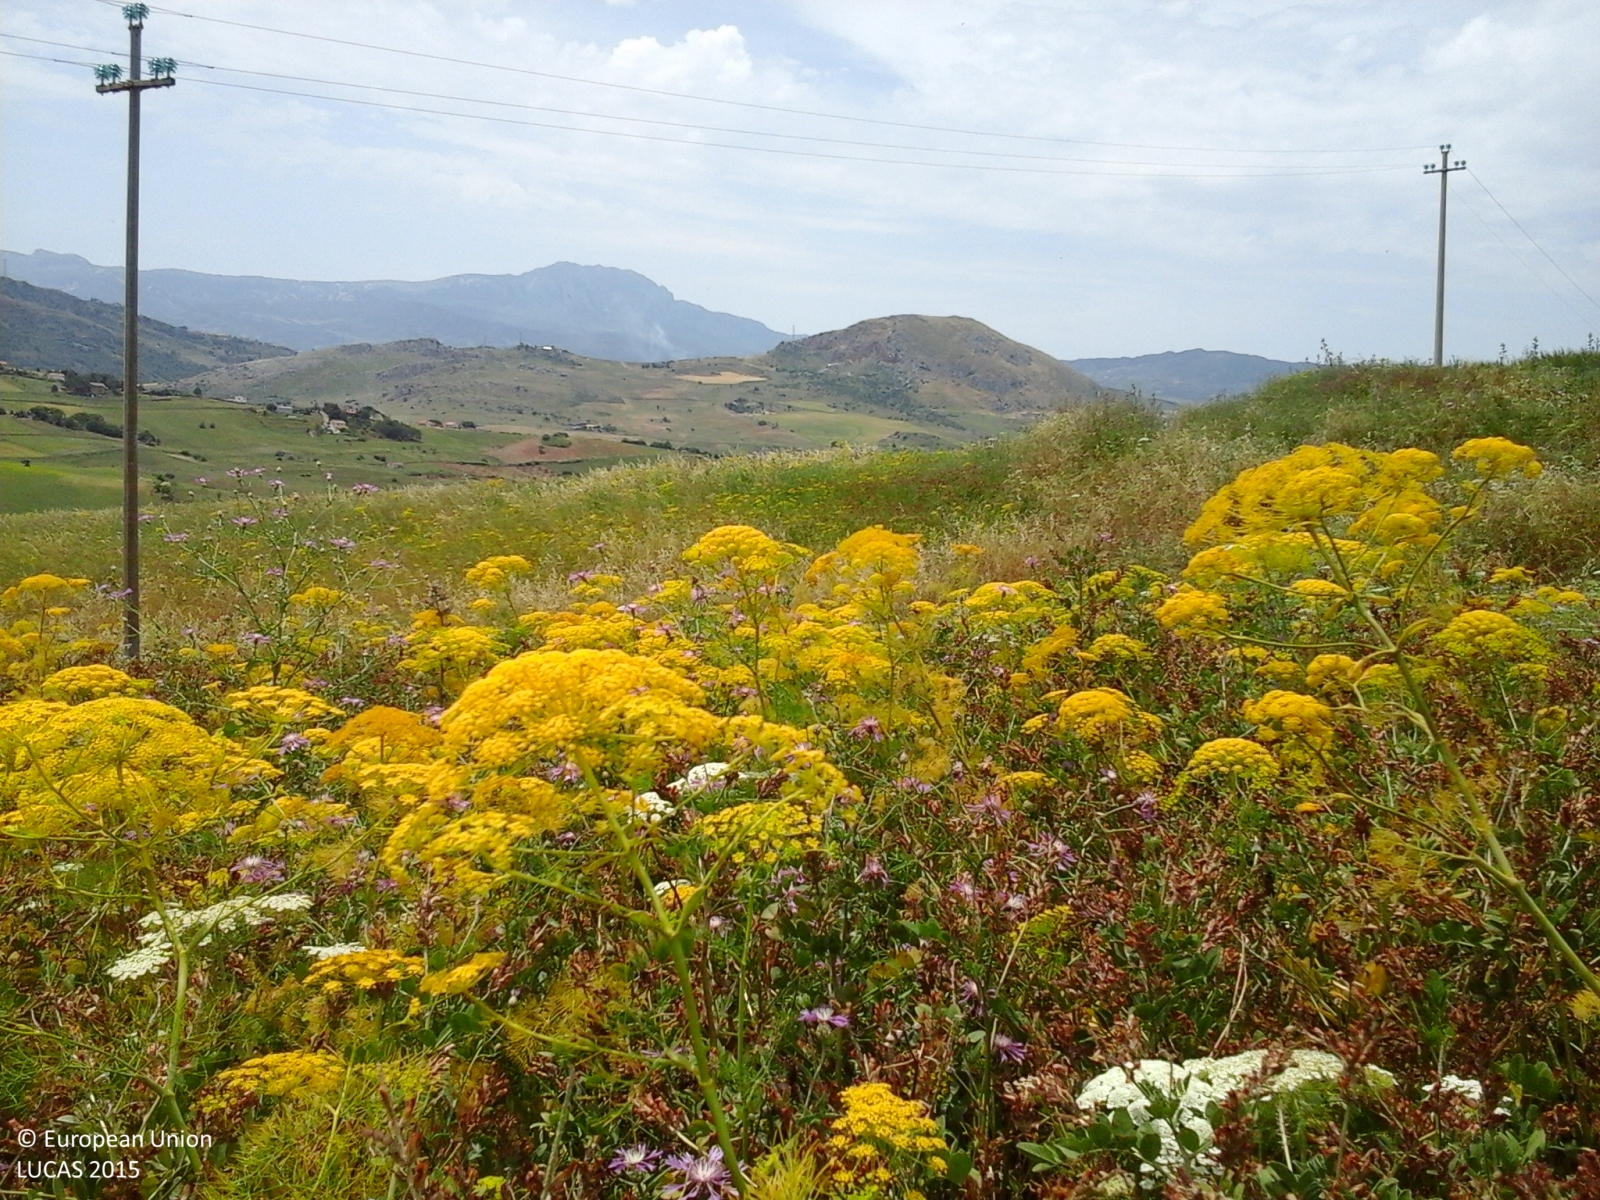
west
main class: Cropland
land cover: Other leguminous and mixtures for fodder
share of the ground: > 75 %
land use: Agriculture (excluding fallow land and kitchen gardens)
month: May
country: IT
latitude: 37.9370
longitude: 13.5135
